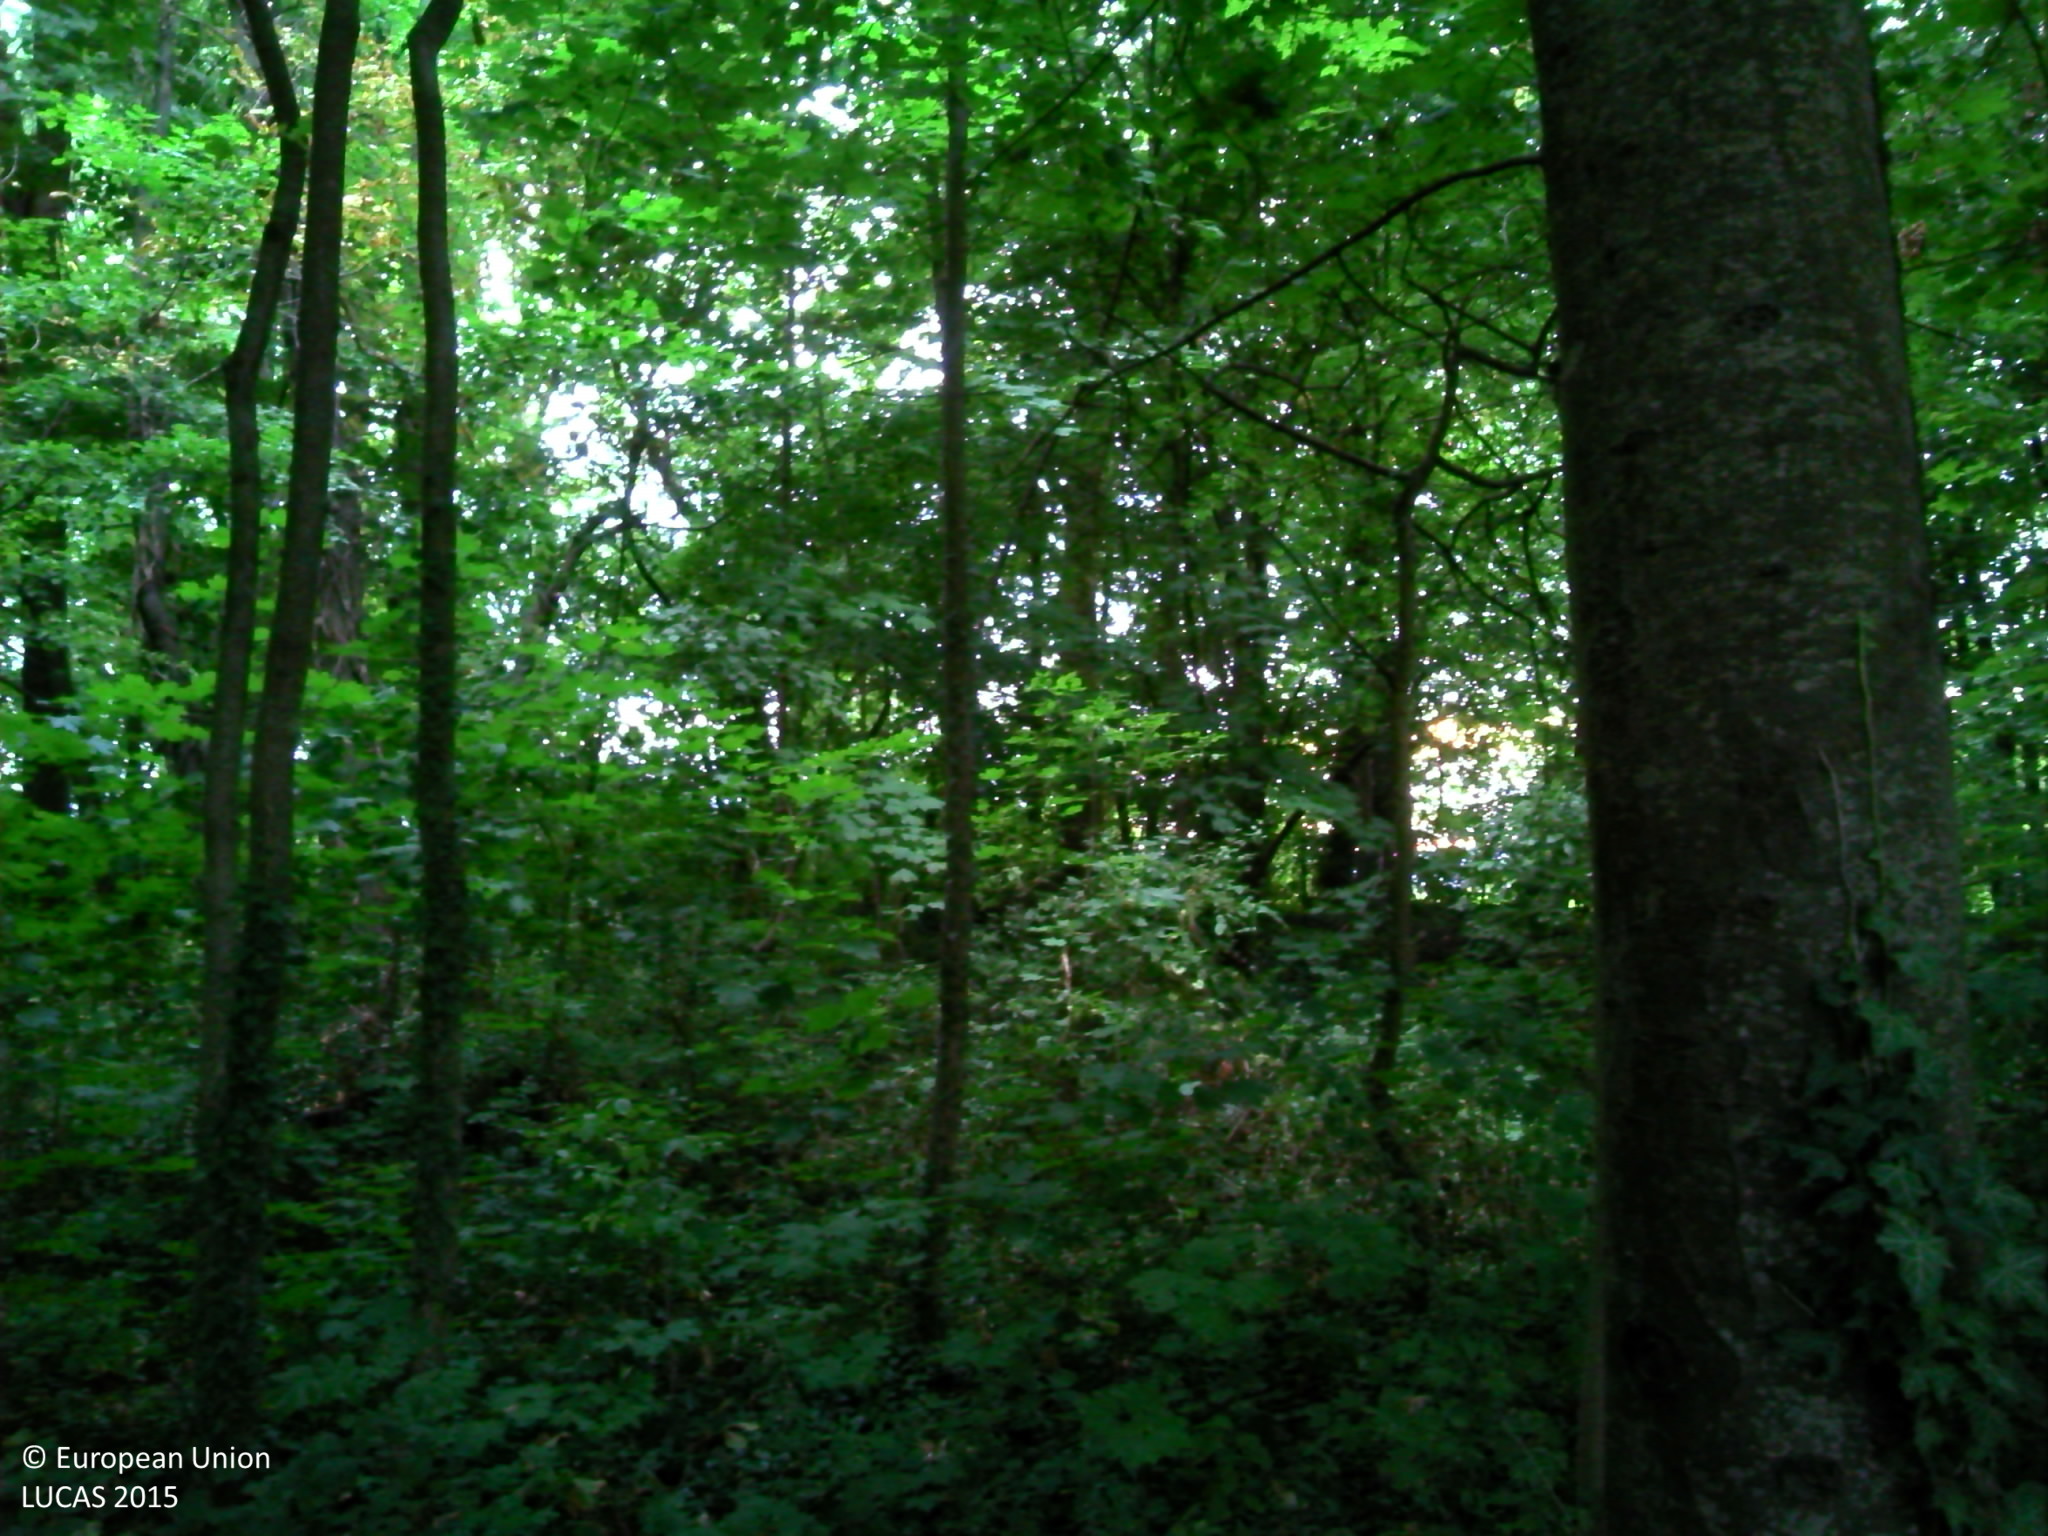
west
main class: Woodland
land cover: Broadleaved woodland
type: mesophytic deciduous forest
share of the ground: > 75 %
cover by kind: broadleaved forest trees 95 %, herbaceous plants 5 %
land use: Forestry
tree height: > 5 m
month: June
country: FR
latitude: 44.7511
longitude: 4.9411
